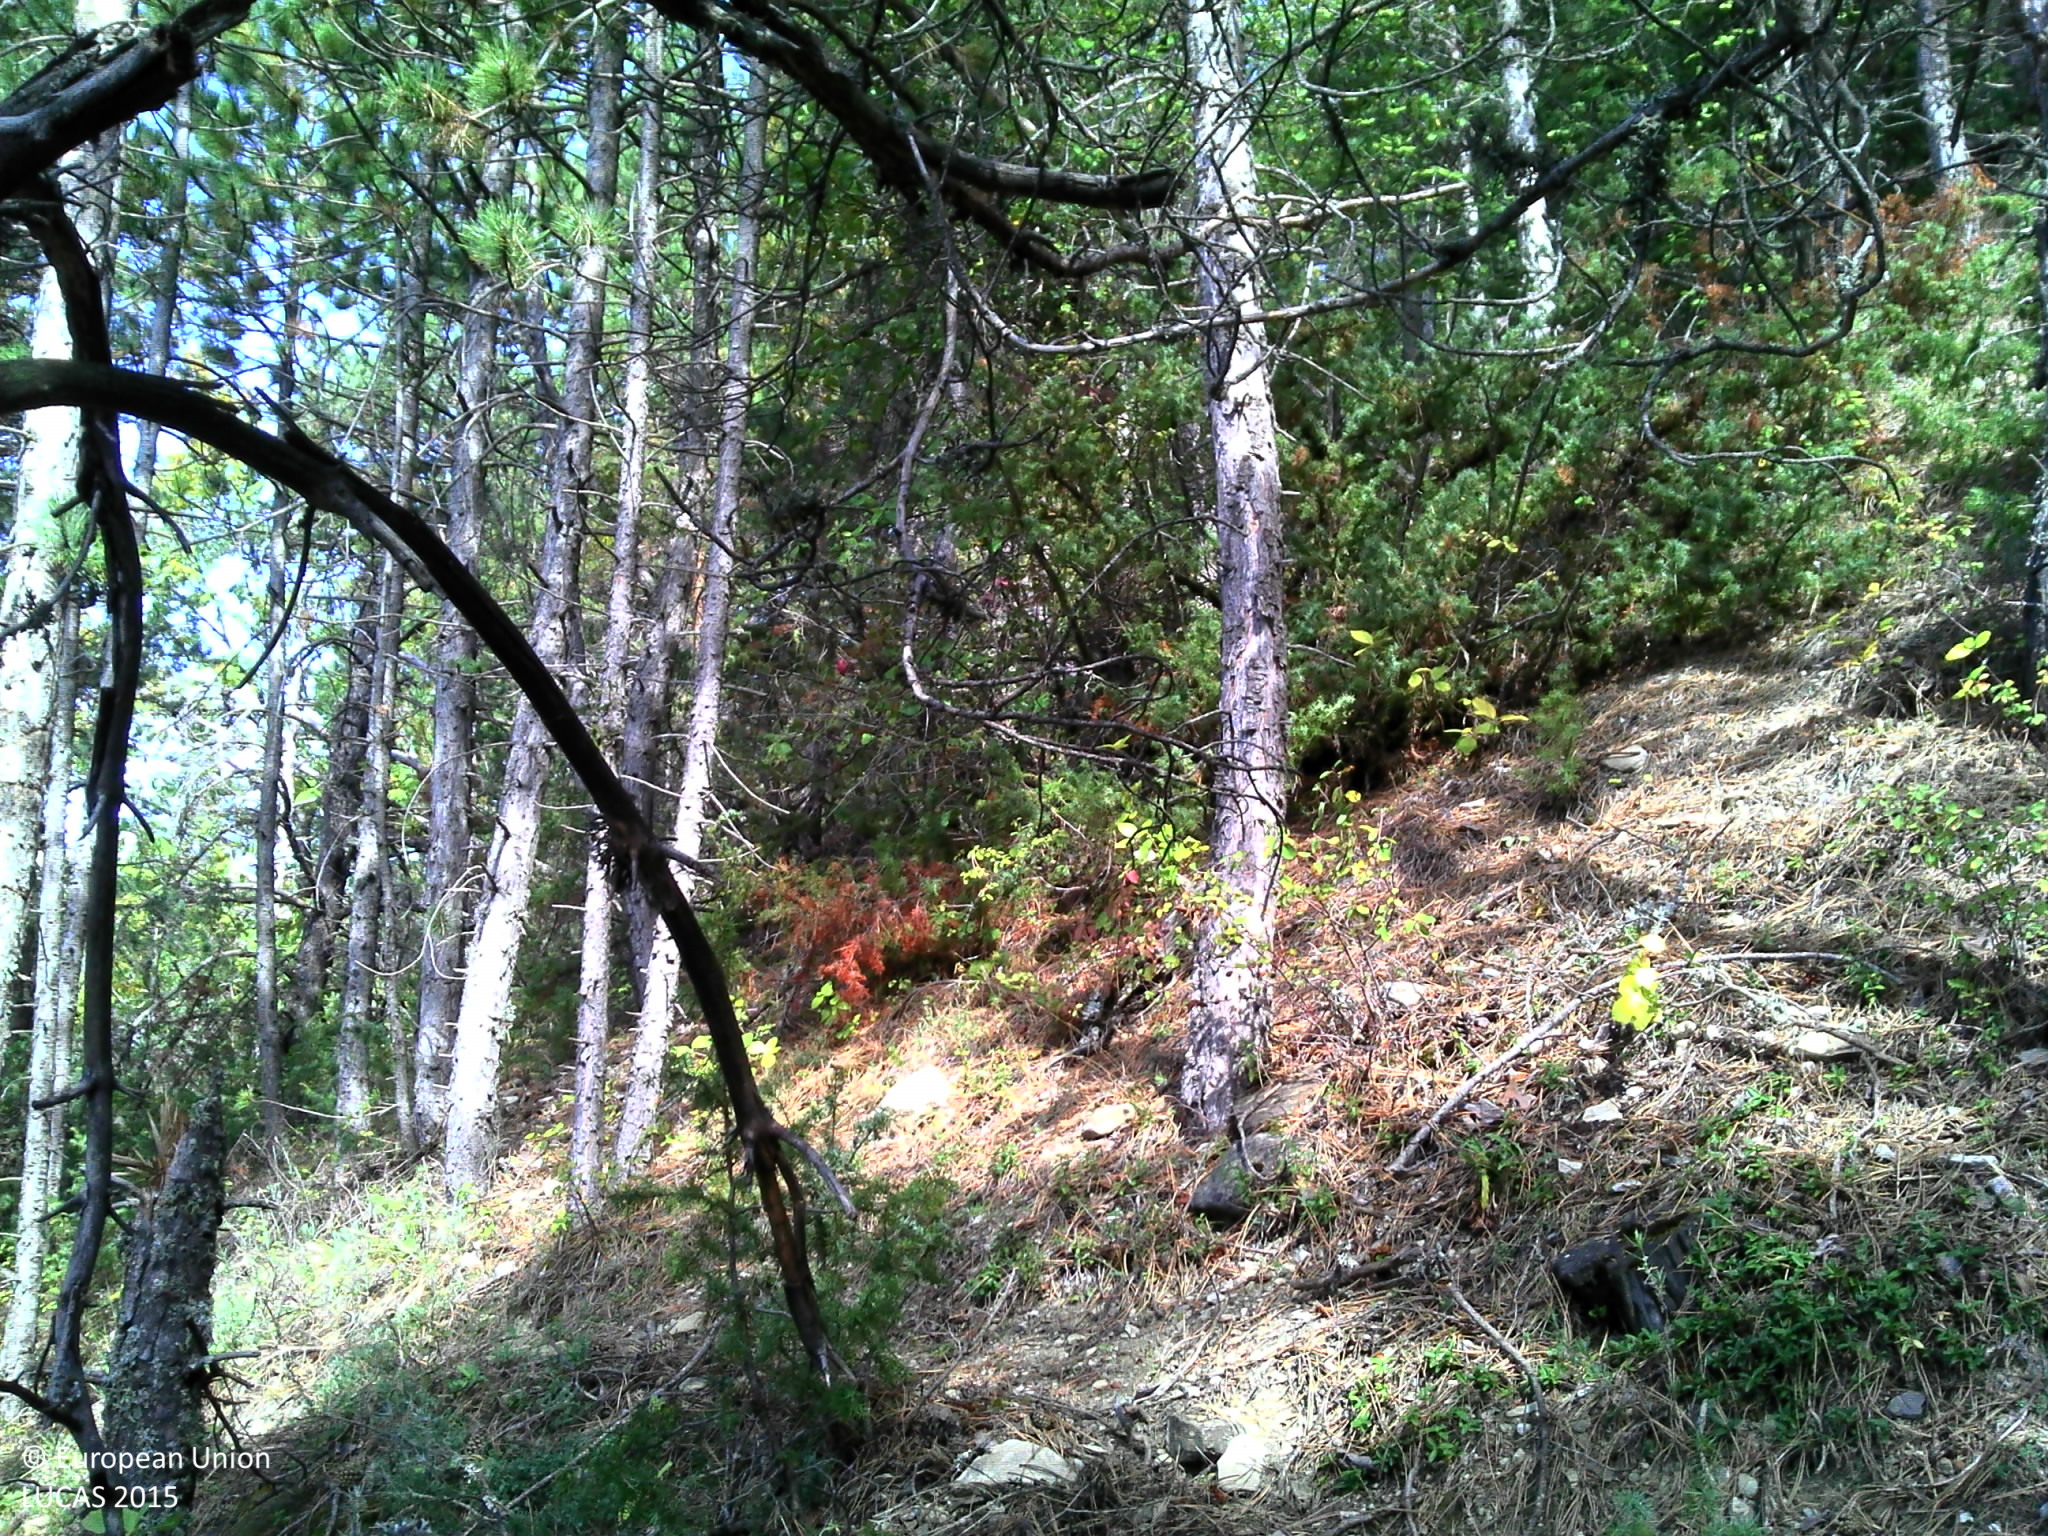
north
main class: Woodland
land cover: Pine dominated coniferous woodland
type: alpine coniferous forest
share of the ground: > 75 %
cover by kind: coniferous forest trees 70 %, shrubs 10 %, unconsolidated bare surface 10 %, broadleaved forest trees 5 %, herbaceous plants 5 %
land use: Semi-natural and natural areas not in use
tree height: > 5 m
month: September
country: FR
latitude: 44.5818
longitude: 6.5427
